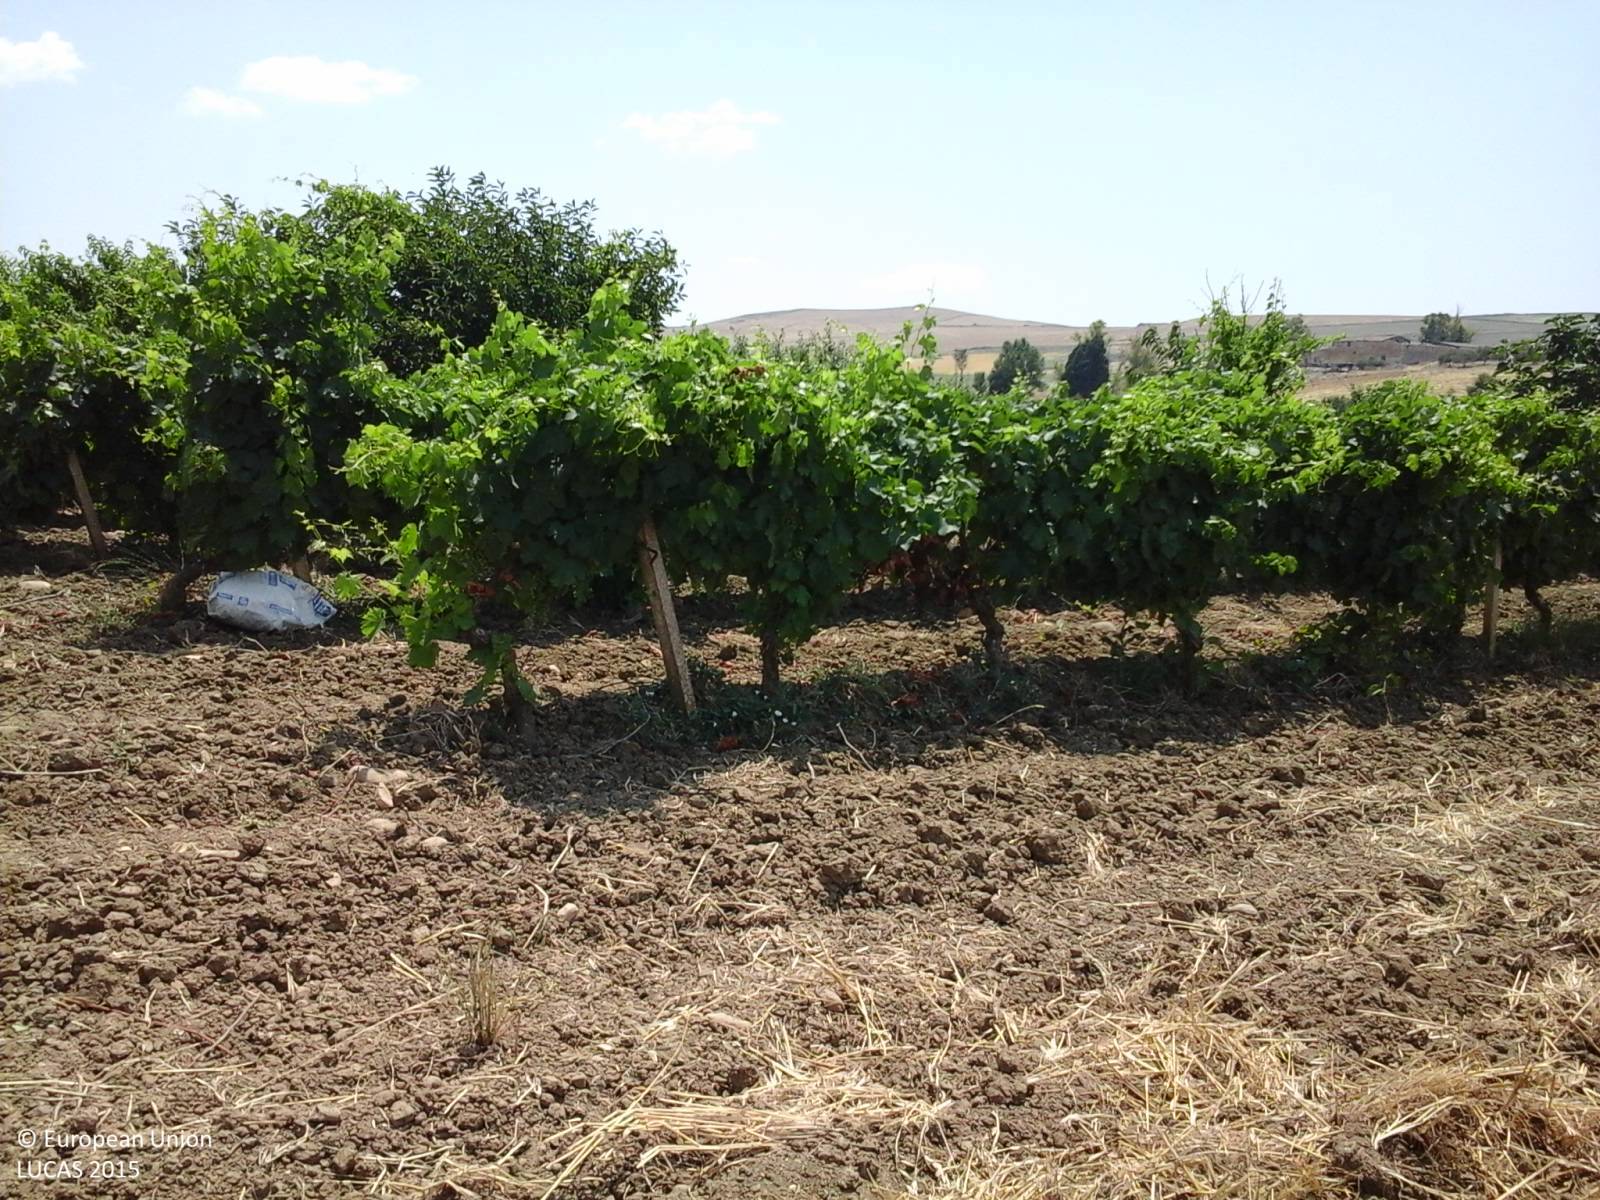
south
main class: Cropland
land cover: Durum wheat
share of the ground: > 75 %
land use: Agriculture (excluding fallow land and kitchen gardens)
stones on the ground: < 10 %
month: July
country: IT
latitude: 37.8015
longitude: 13.2358
